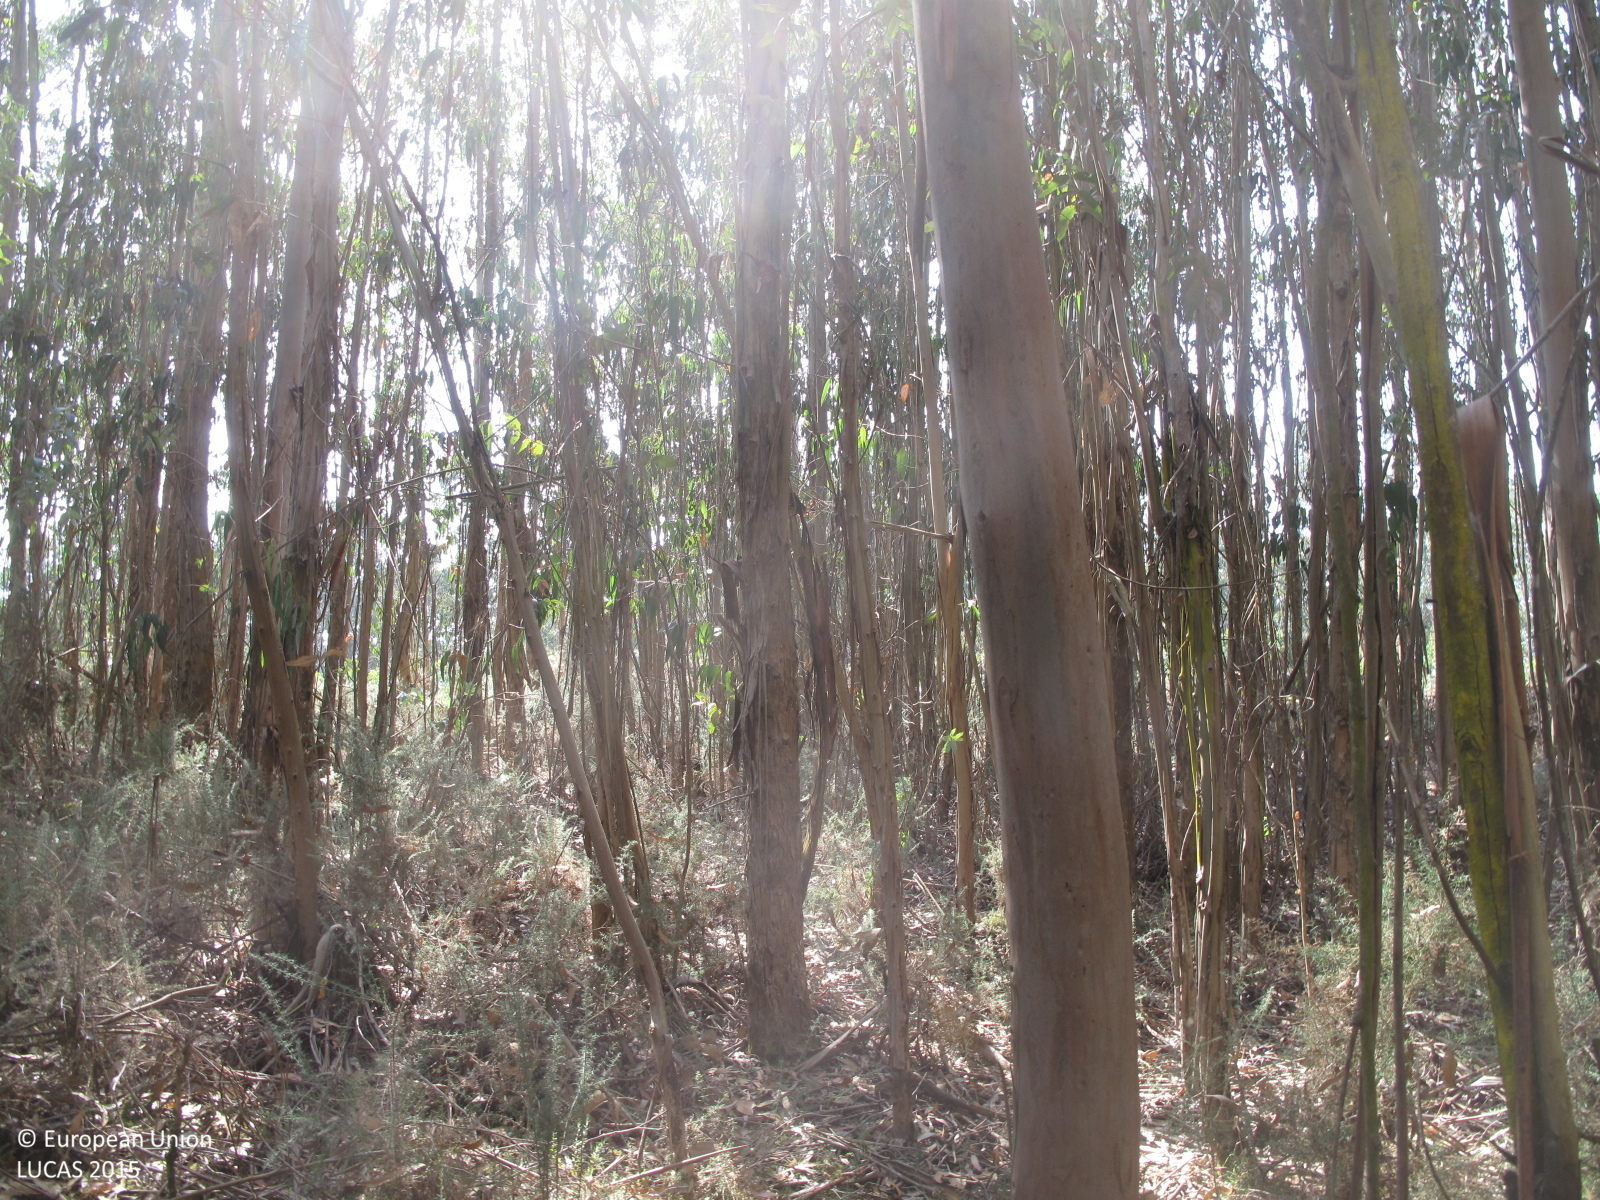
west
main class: Woodland
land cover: Broadleaved woodland
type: exotic forest
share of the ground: > 75 %
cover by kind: broadleaved forest trees 90 %, shrubs 5 %, unconsolidated bare surface 5 %
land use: Forestry
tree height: > 5 m
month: July
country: ES
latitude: 43.4435
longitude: -8.3050
